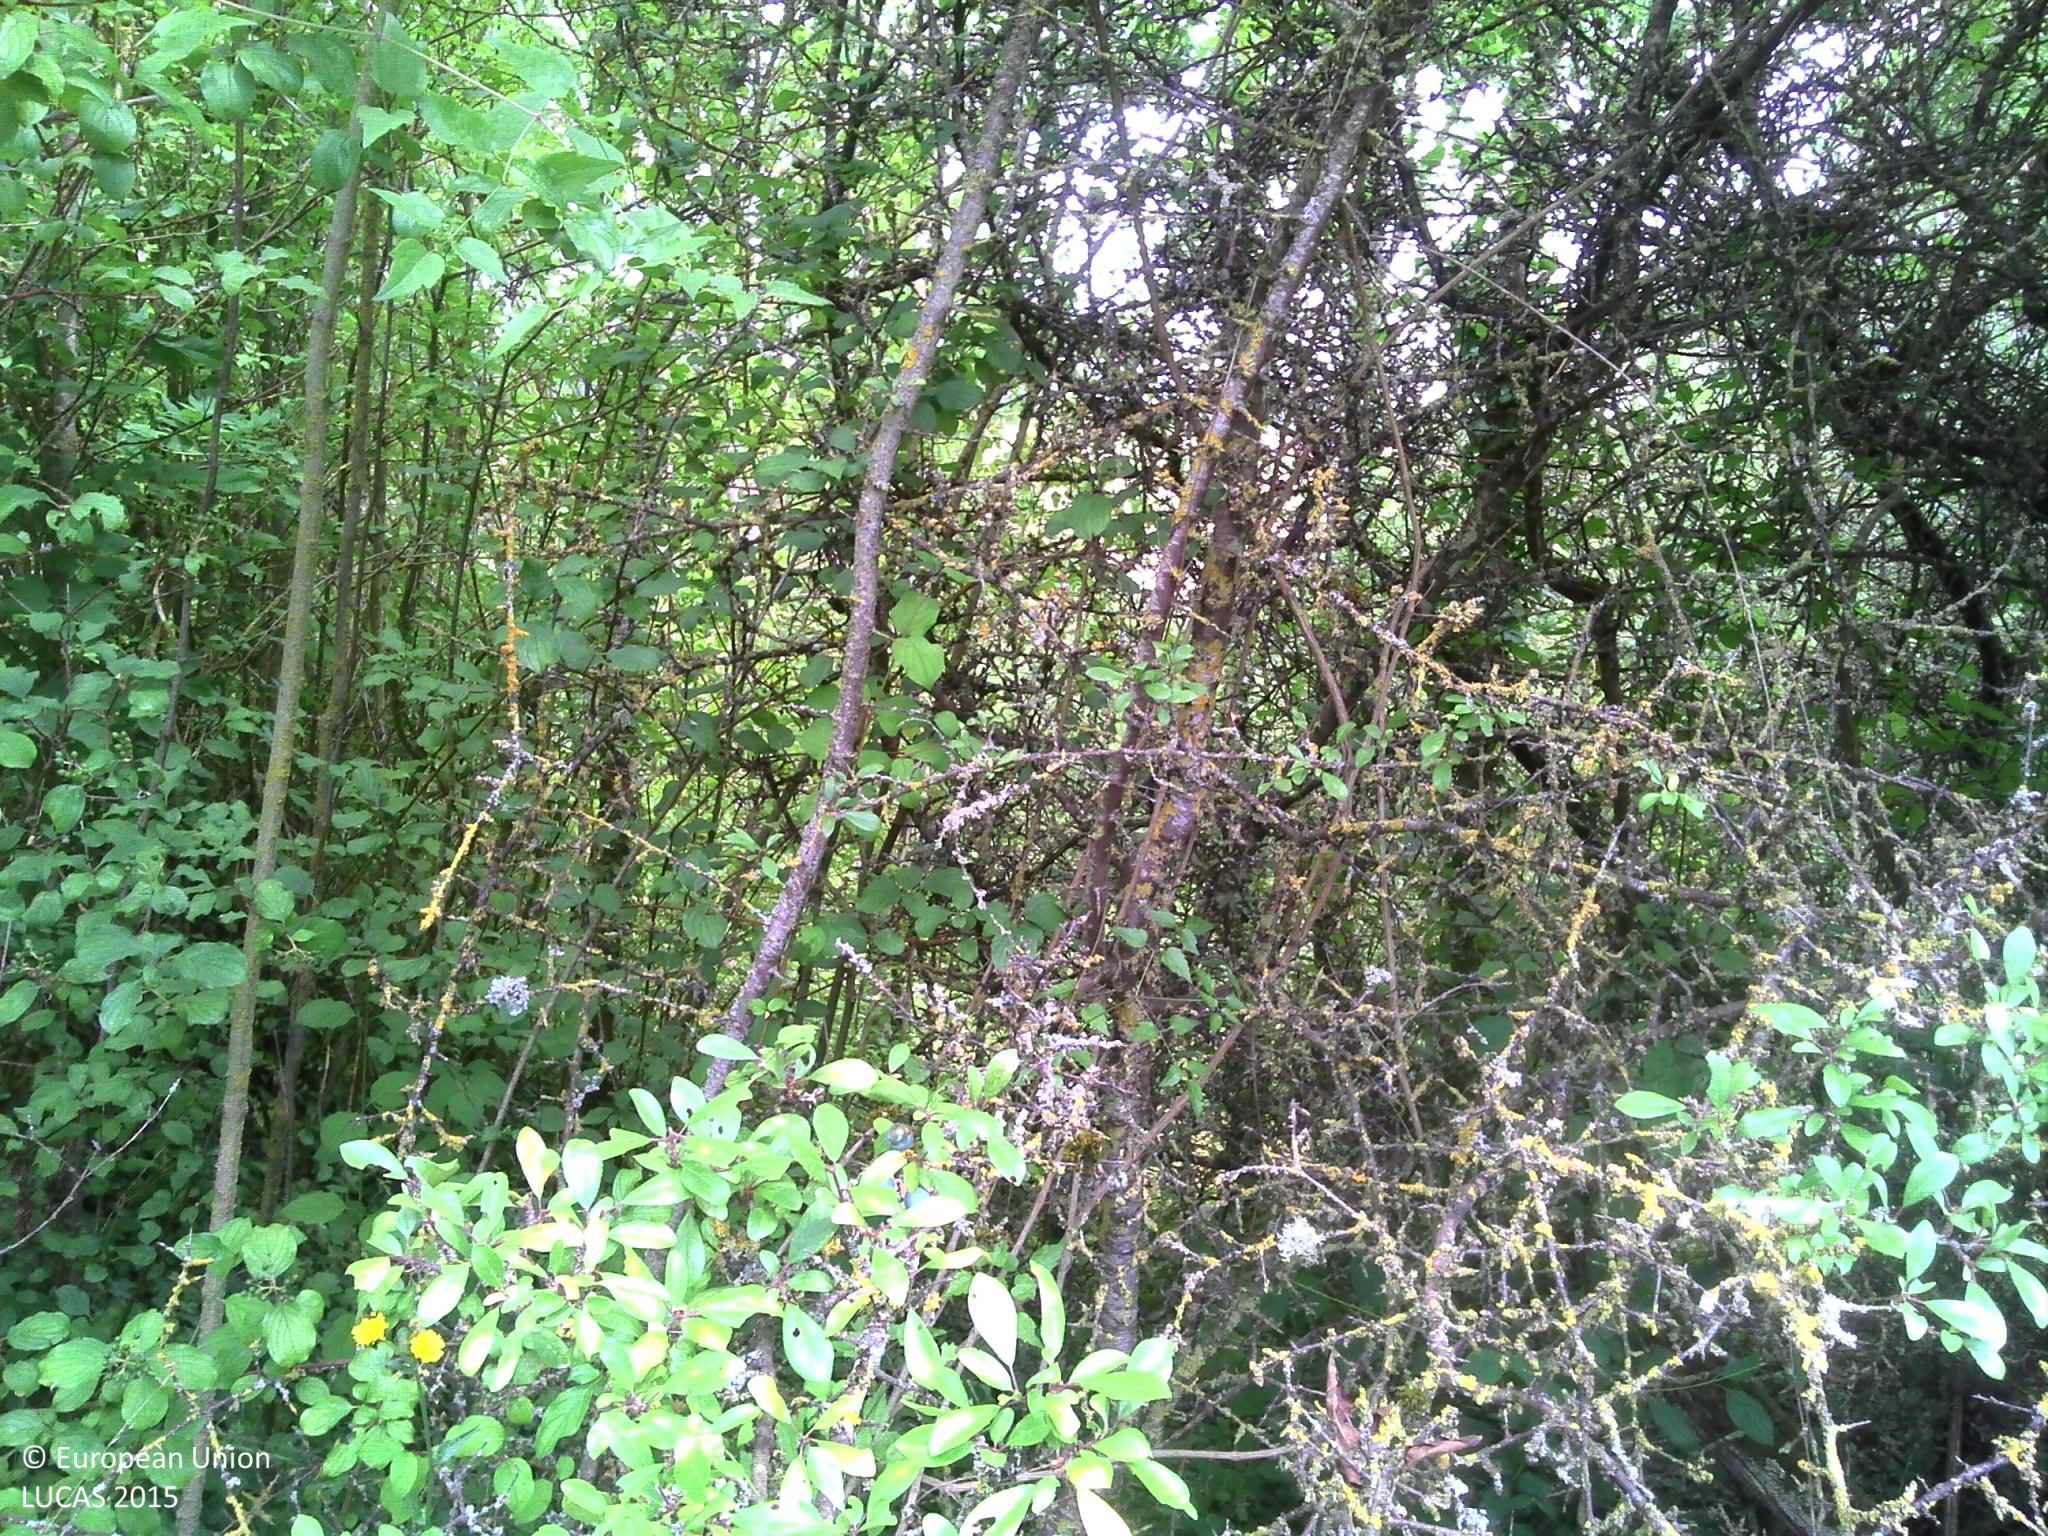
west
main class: Grassland
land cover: Grassland with sparse tree/shrub cover
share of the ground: > 75 %
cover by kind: herbaceous plants 90 %, broadleaved forest trees 5 %, shrubs 5 %
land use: Agriculture (excluding fallow land and kitchen gardens)
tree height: > 5 m
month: July
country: FR
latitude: 48.2967
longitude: 3.4023
